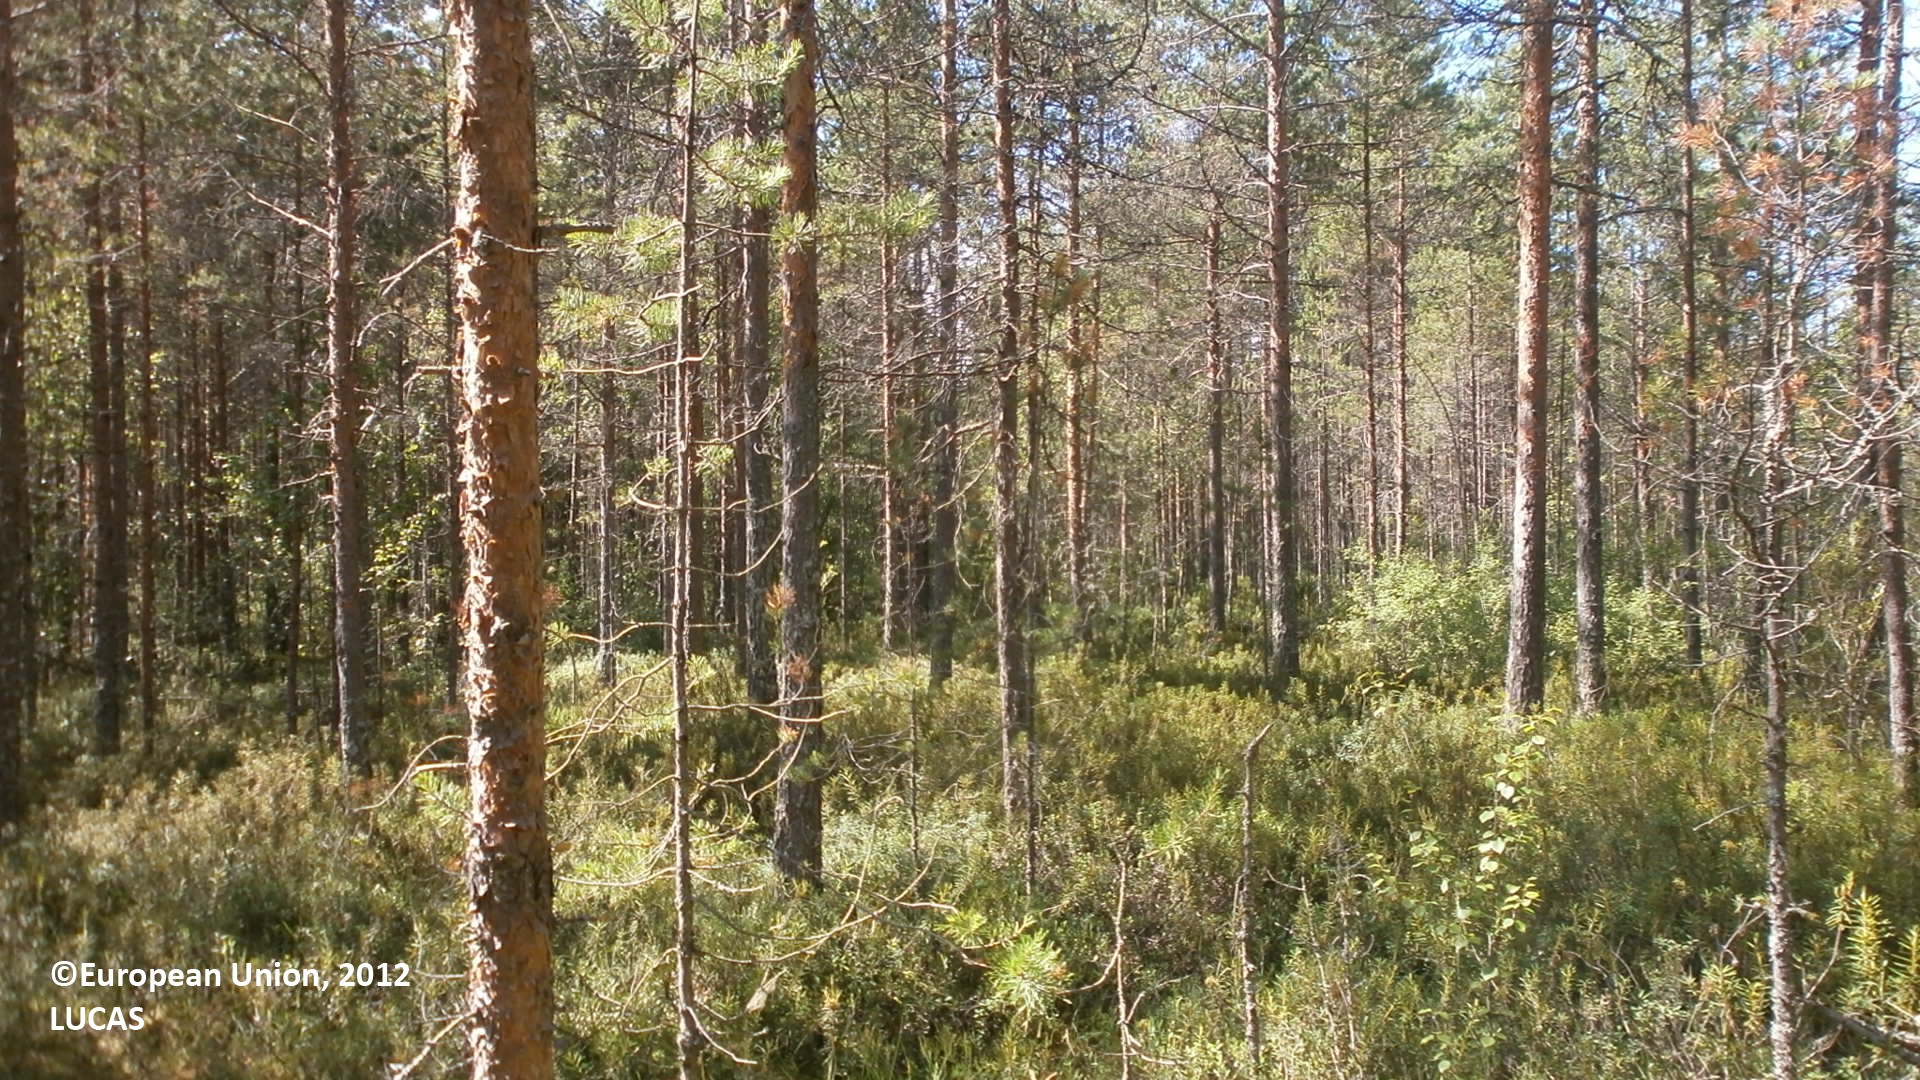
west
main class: Woodland
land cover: Pine dominated coniferous woodland
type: mire and swamp forests
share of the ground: 50 - 75 %
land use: Forestry
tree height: > 5 m
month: July
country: FI
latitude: 64.1462
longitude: 24.3548
